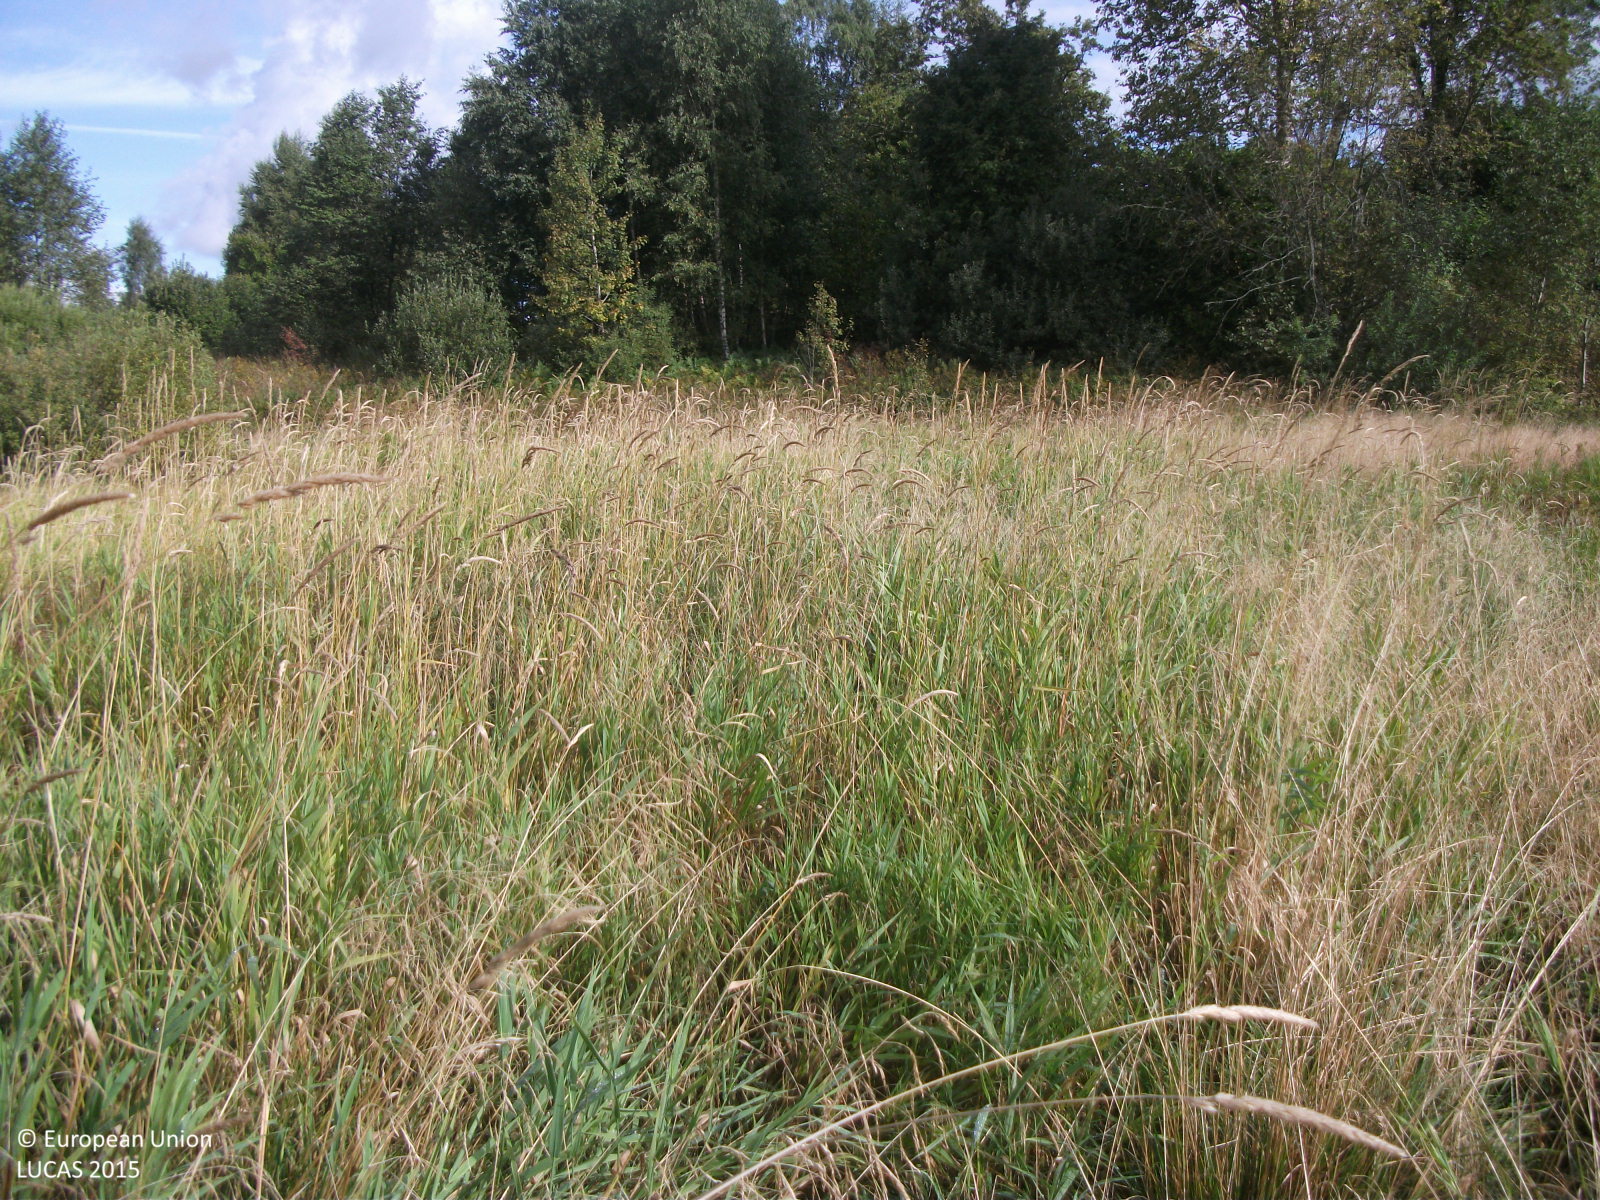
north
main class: Grassland
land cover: Spontaneously vegetated surfaces
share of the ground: > 75 %
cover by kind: herbaceous plants 95 %, shrubs 5 %
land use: Semi-natural and natural areas not in use
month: September
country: LV
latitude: 57.5846
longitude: 24.7310
